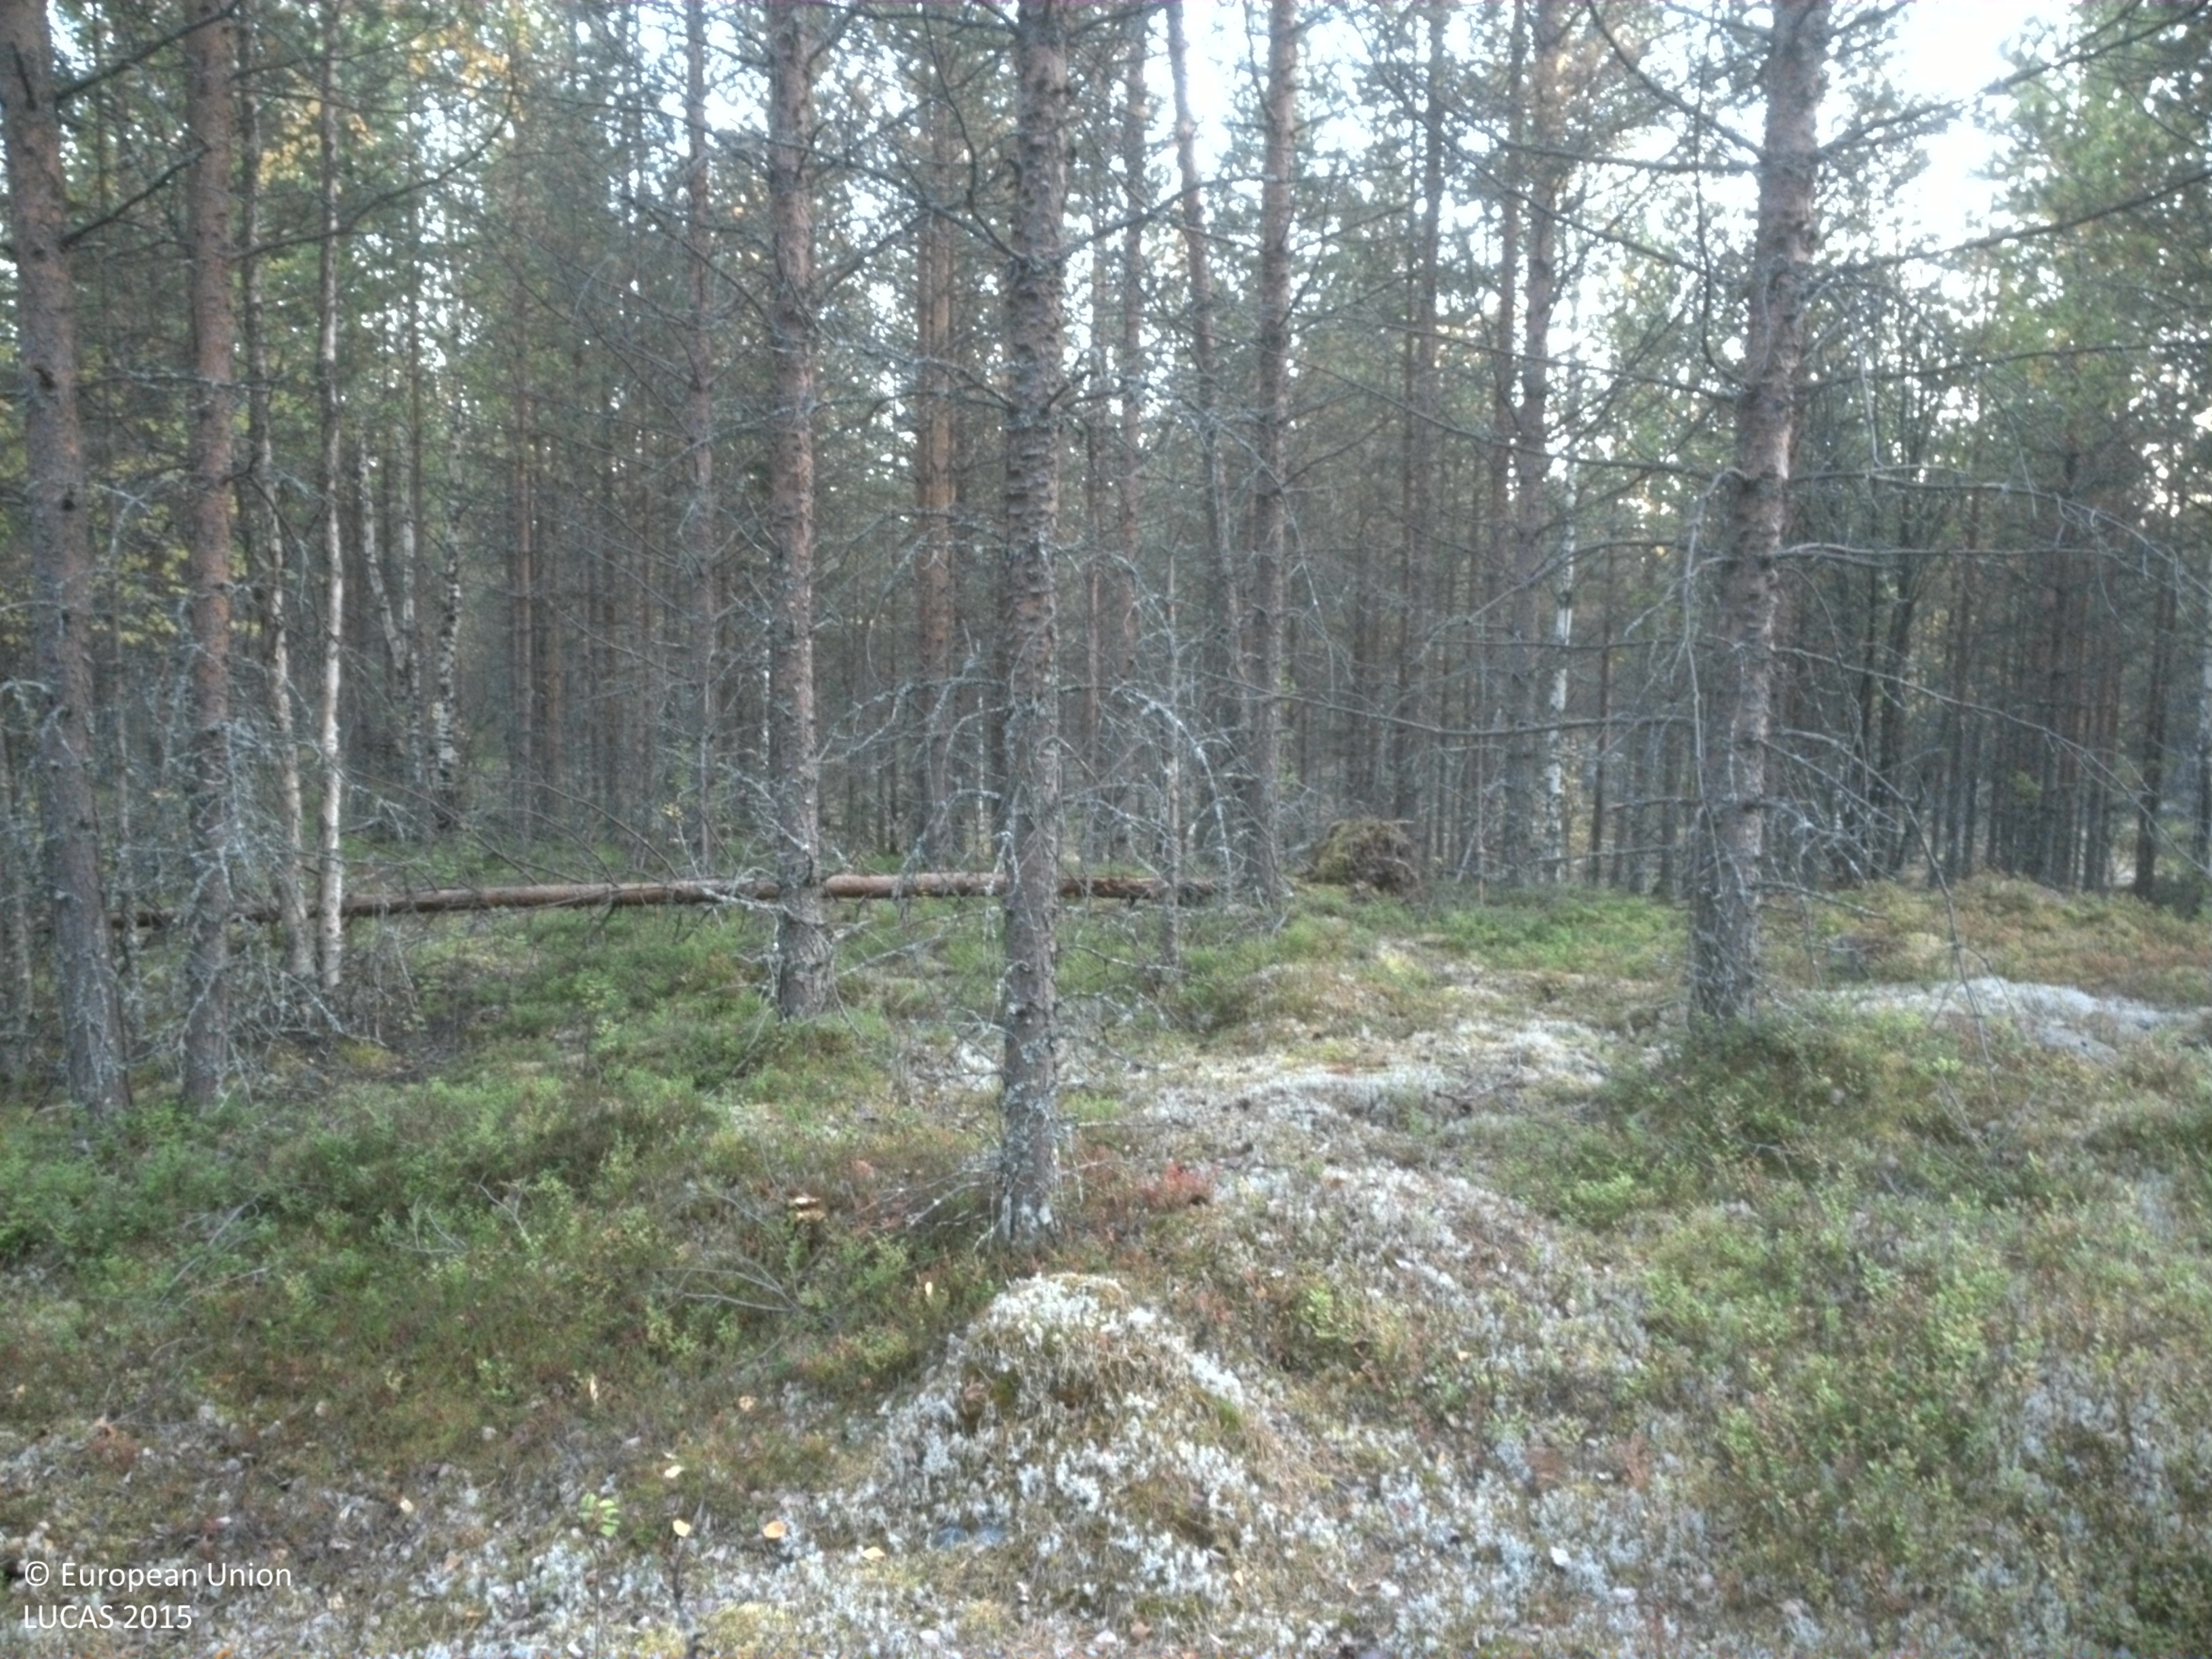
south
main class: Woodland
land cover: Pine dominated coniferous woodland
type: boreal forest
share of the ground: 25 - 50 %
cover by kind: coniferous forest trees 40 %, lichens and mosses 25 %, shrubs 20 %, herbaceous plants 10 %, broadleaved forest trees 5 %
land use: Forestry
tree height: > 5 m
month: September
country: SE
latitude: 64.4280
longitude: 20.0037
